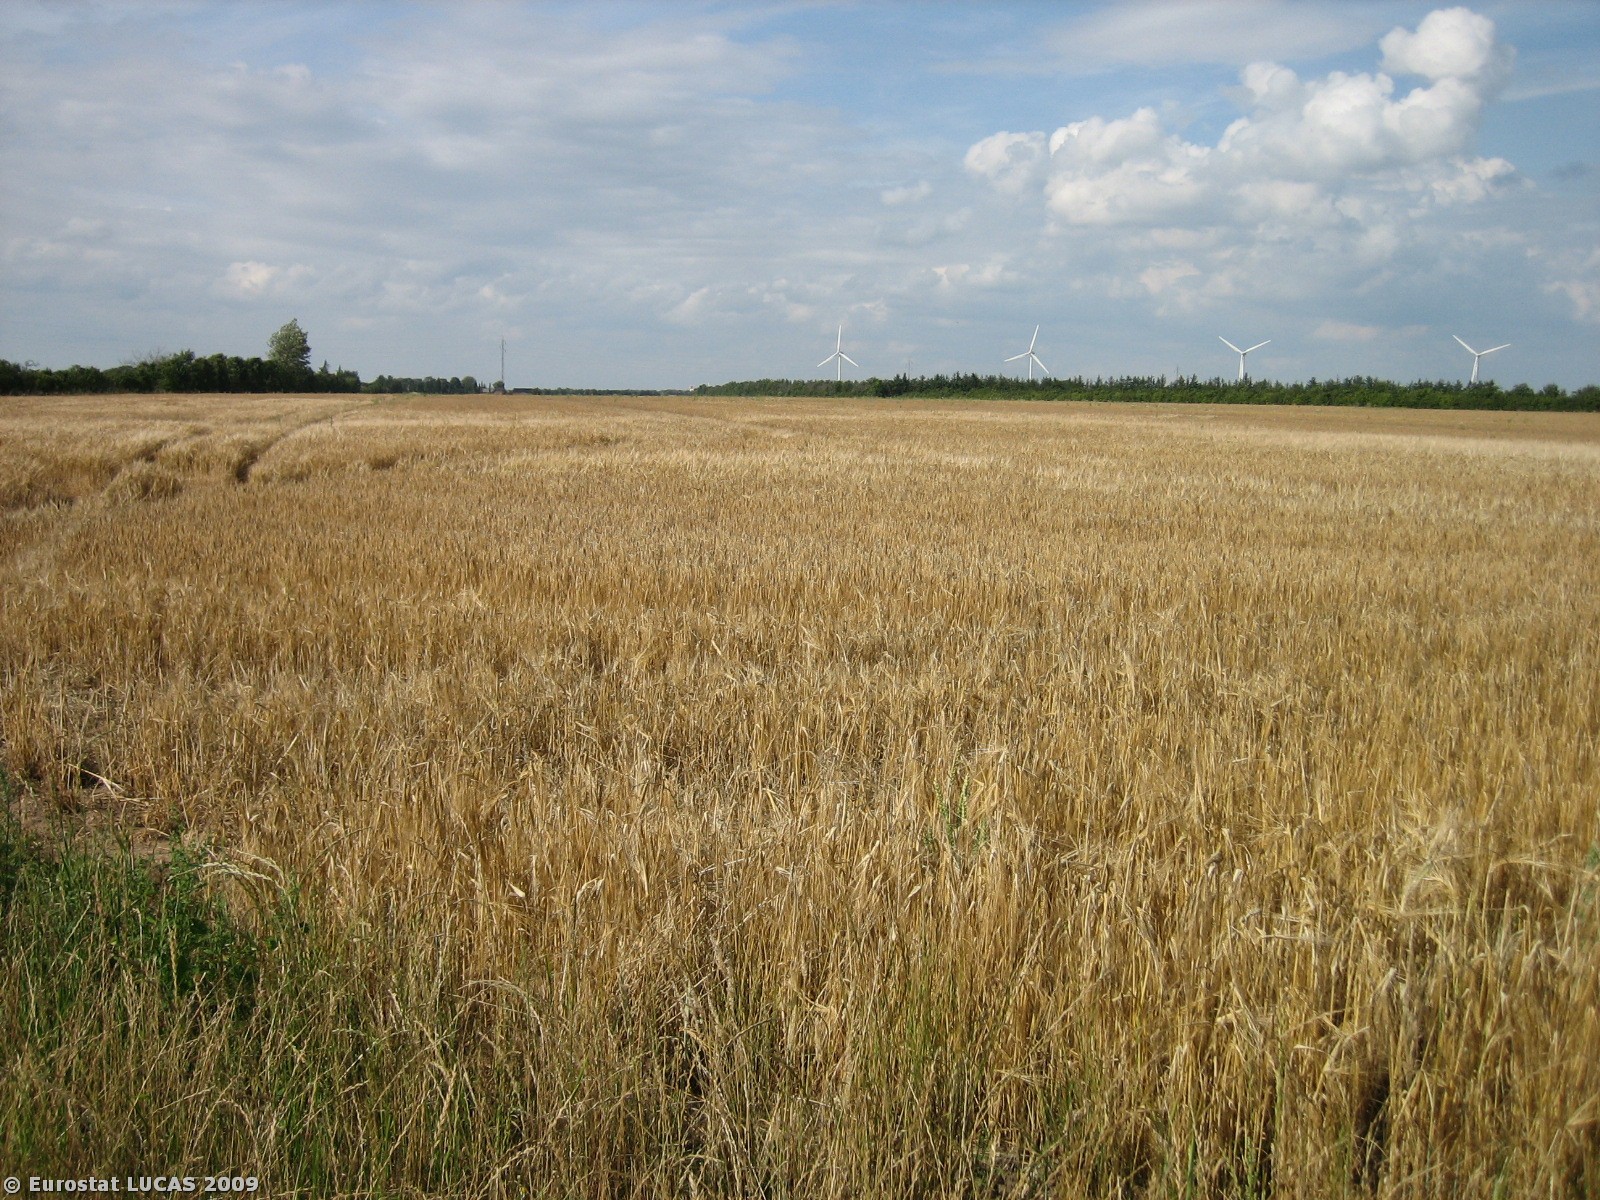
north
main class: Cropland
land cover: Barley
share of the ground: > 75 %
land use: Agriculture (excluding fallow land and kitchen gardens)
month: July
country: DK
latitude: 55.7693
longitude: 8.8694
